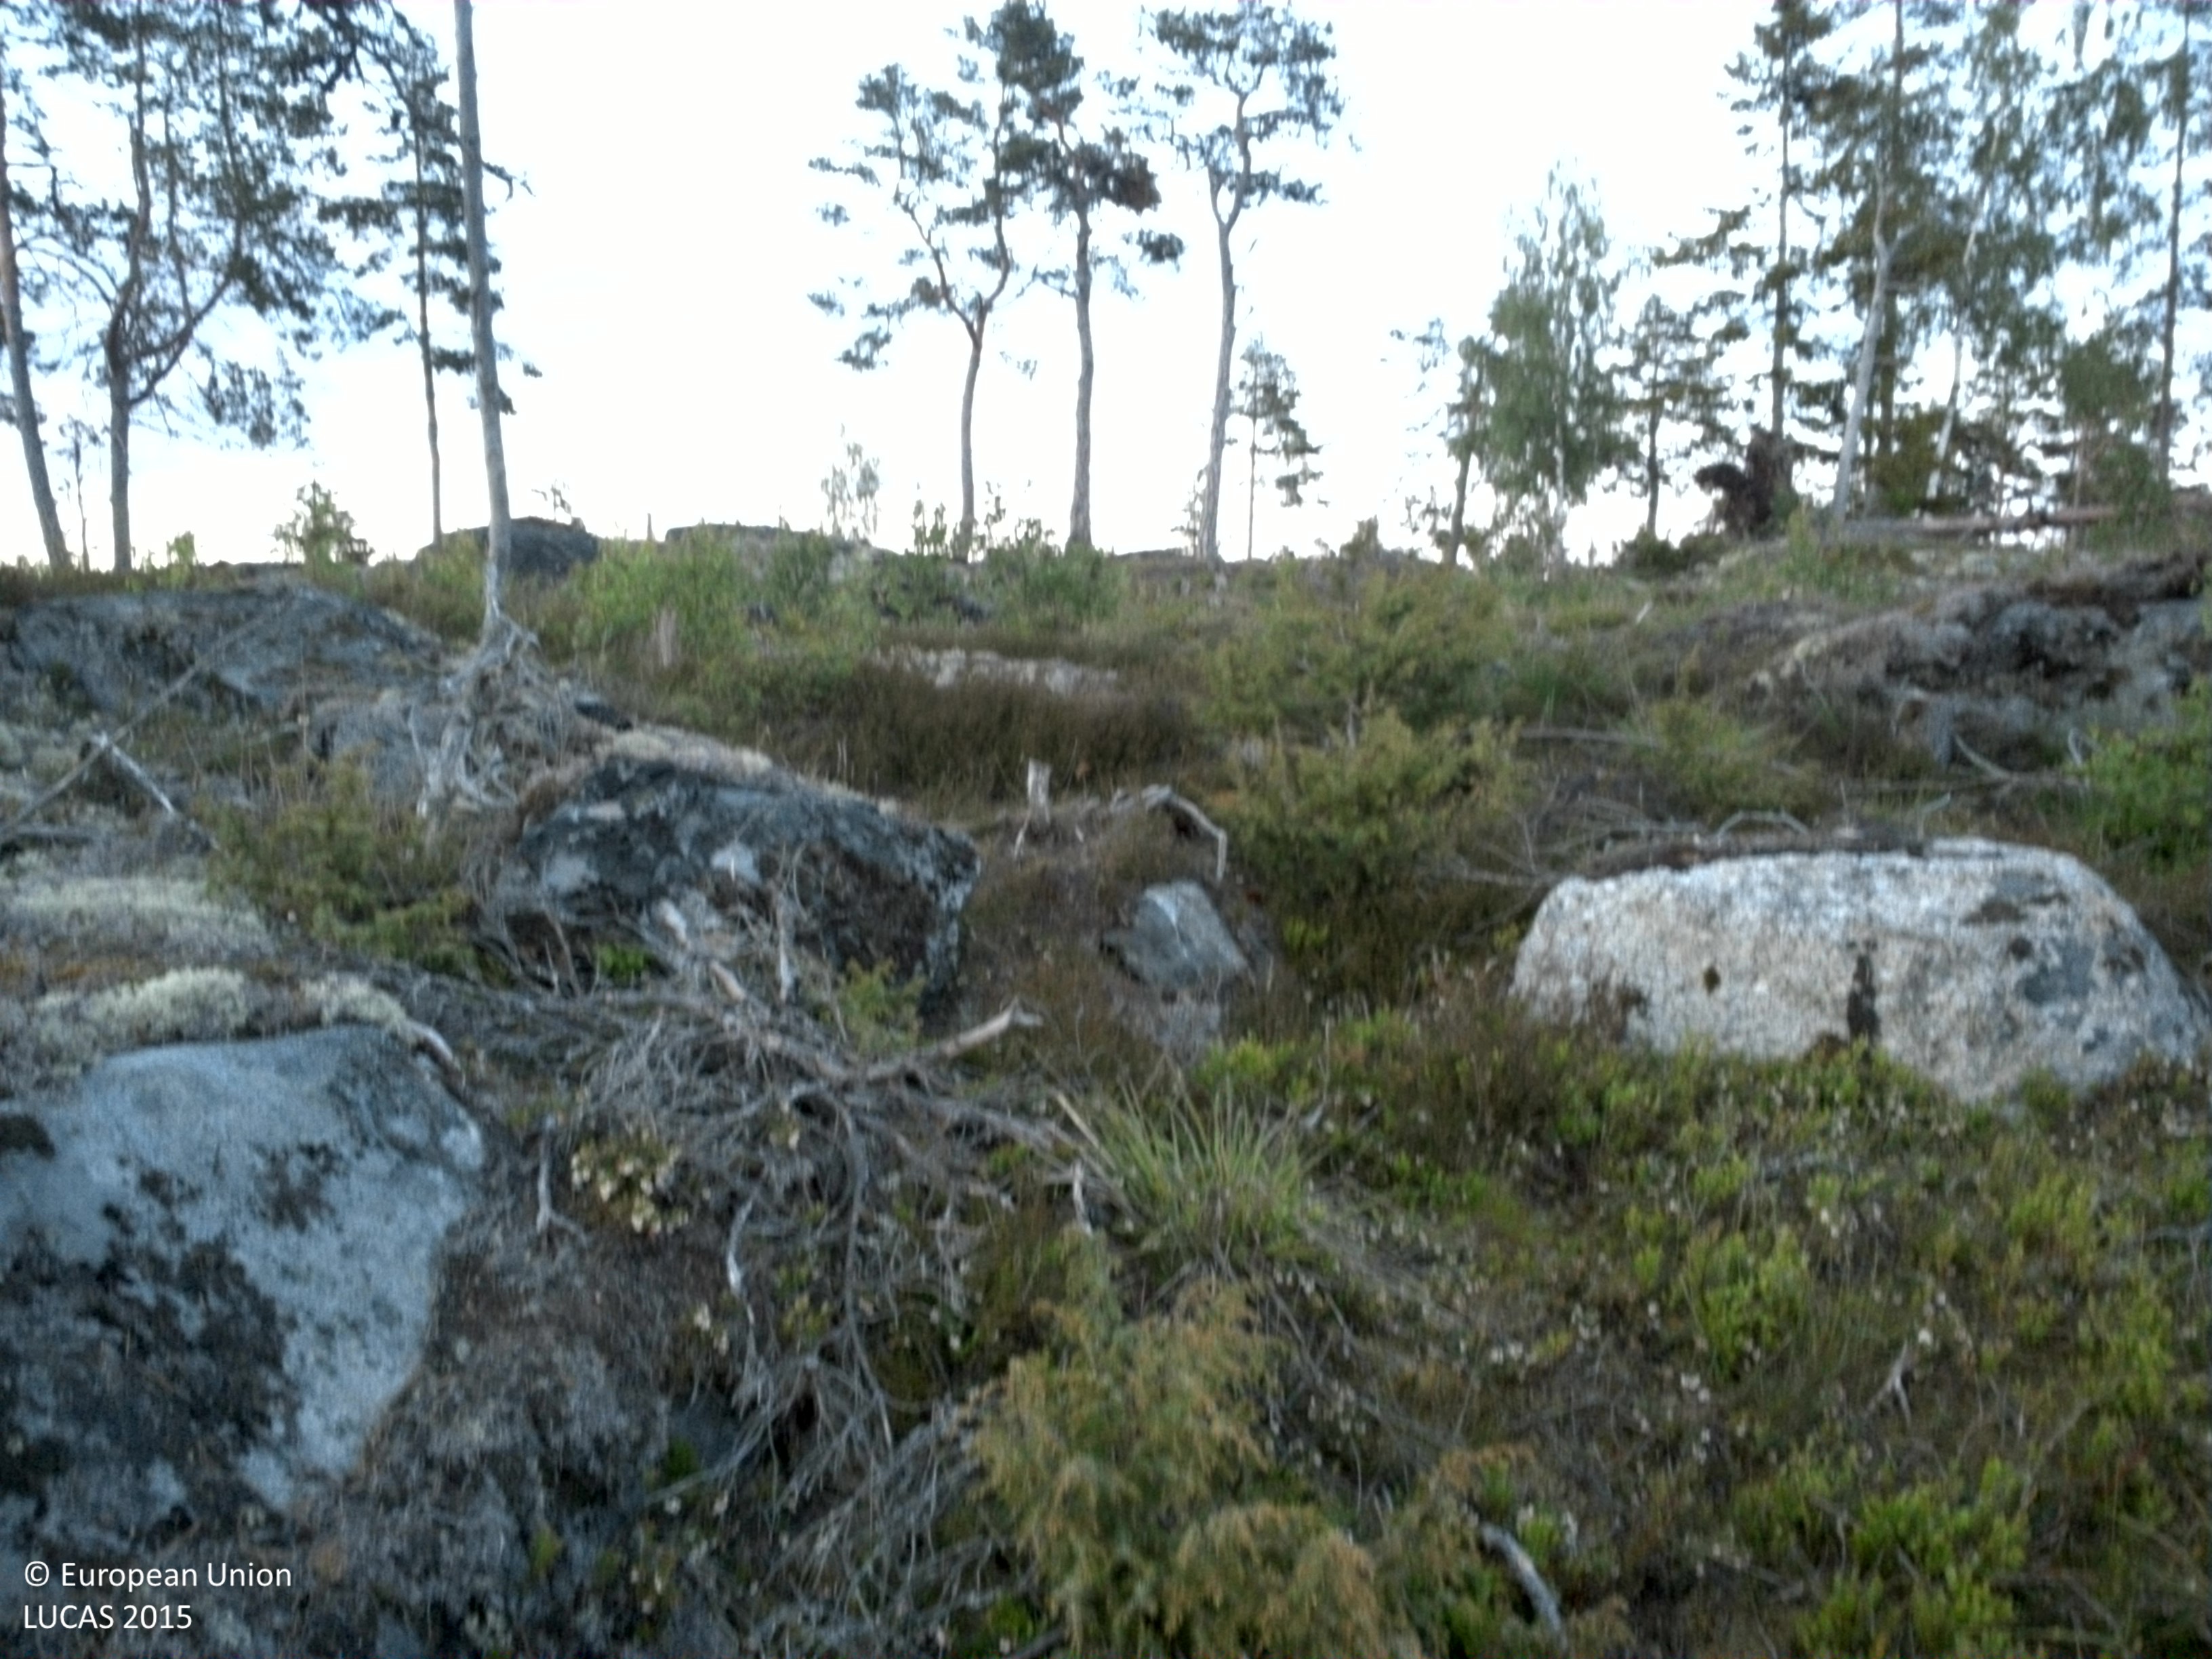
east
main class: Shrubland
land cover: Shrubland with sparse tree cover
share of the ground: 25 - 50 %
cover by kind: shrubs 35 %, consolidated bare surface 30 %, herbaceous plants 20 %, lichens and mosses 10 %, coniferous forest trees 5 %
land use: Forestry
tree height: > 5 m
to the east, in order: Shrubland with sparse tree cover; Single bushes/trees; Rock outcrops; Pine dominated coniferous woodland; Shrubland with sparse tree cover; Other bare soil; Rocks and stones; Ditches and canals; Paved roads, cycling and walking lanes; Ditches and canals; Pine dominated coniferous woodland
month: June
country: SE
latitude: 60.0516
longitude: 18.7805
